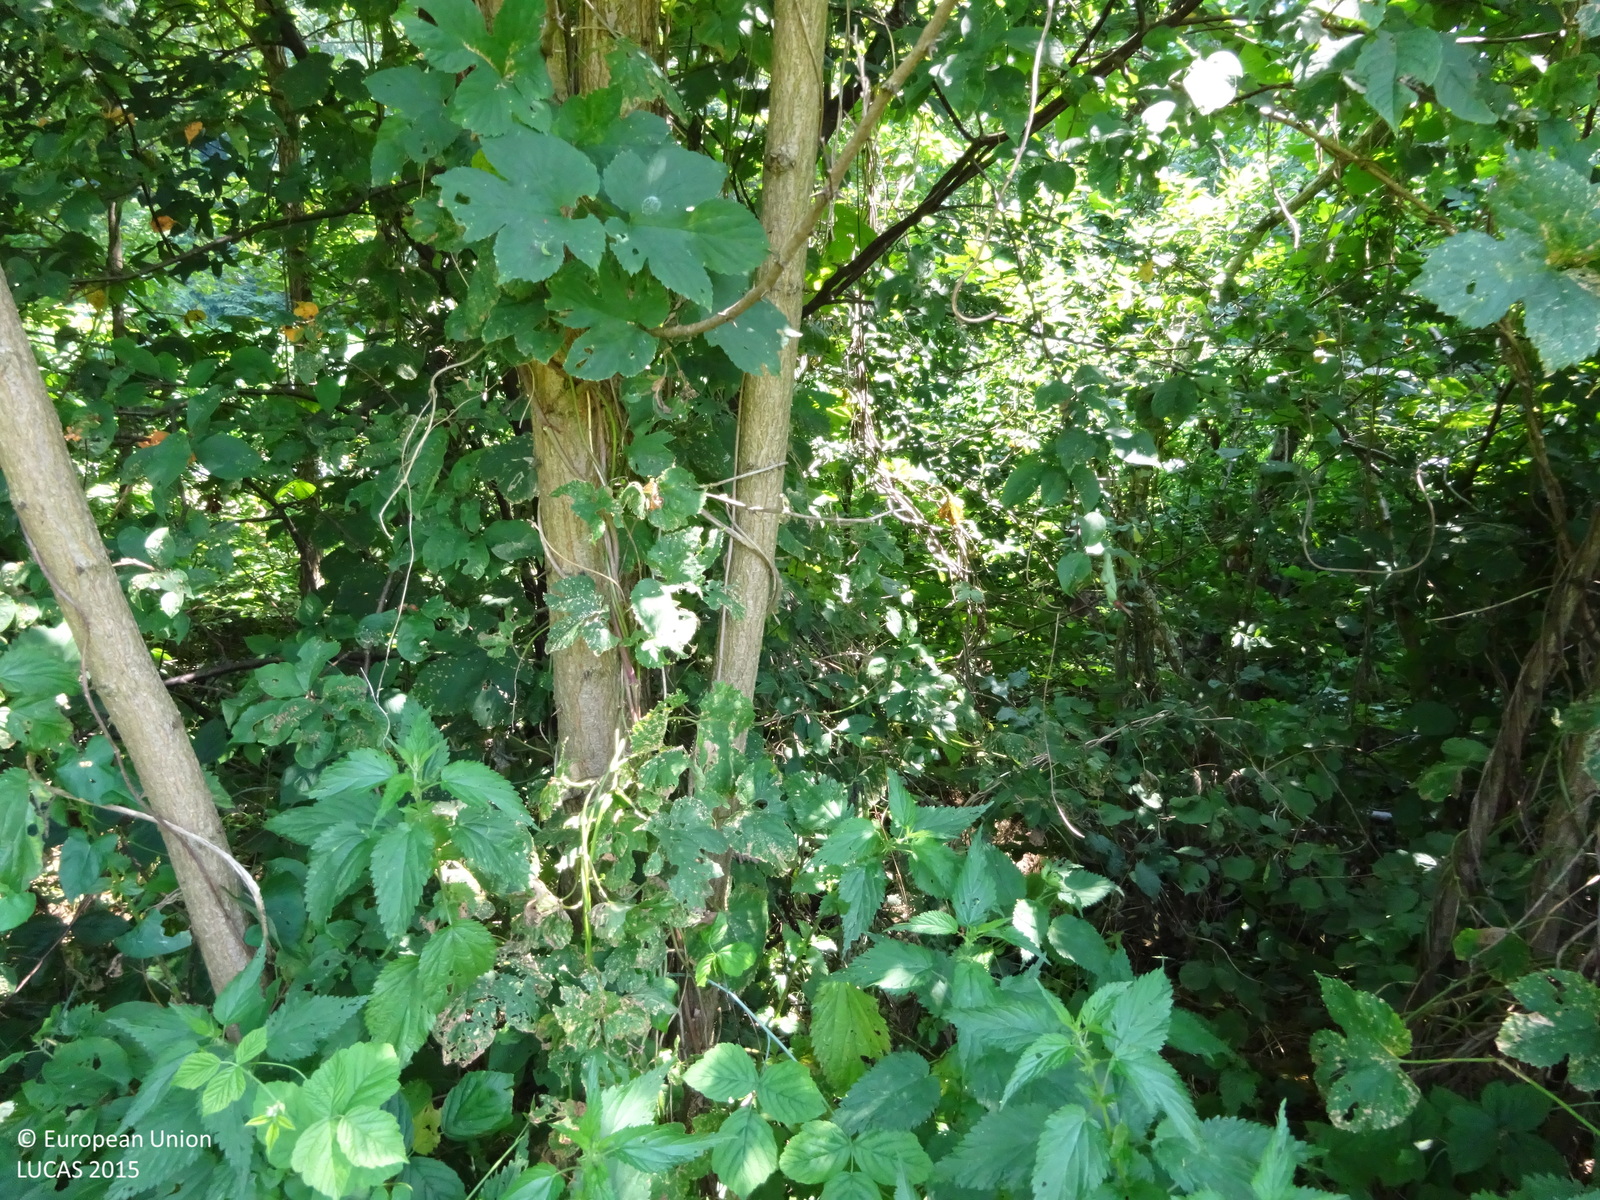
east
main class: Woodland
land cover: Broadleaved woodland
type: floodplain forest
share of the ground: 25 - 50 %
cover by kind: broadleaved forest trees 50 %, shrubs 50 %
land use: Forestry
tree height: > 5 m
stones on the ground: 10 - 25 %
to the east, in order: Broadleaved woodland; Rivers and streams; Broadleaved woodland; Grass margins; Paved roads, cycling and walking lanes; Grass margins; Ditches and canals; Grass margins; Maize; Spruce dominated mixed woodland
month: July
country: AT
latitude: 46.9258
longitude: 15.9500
